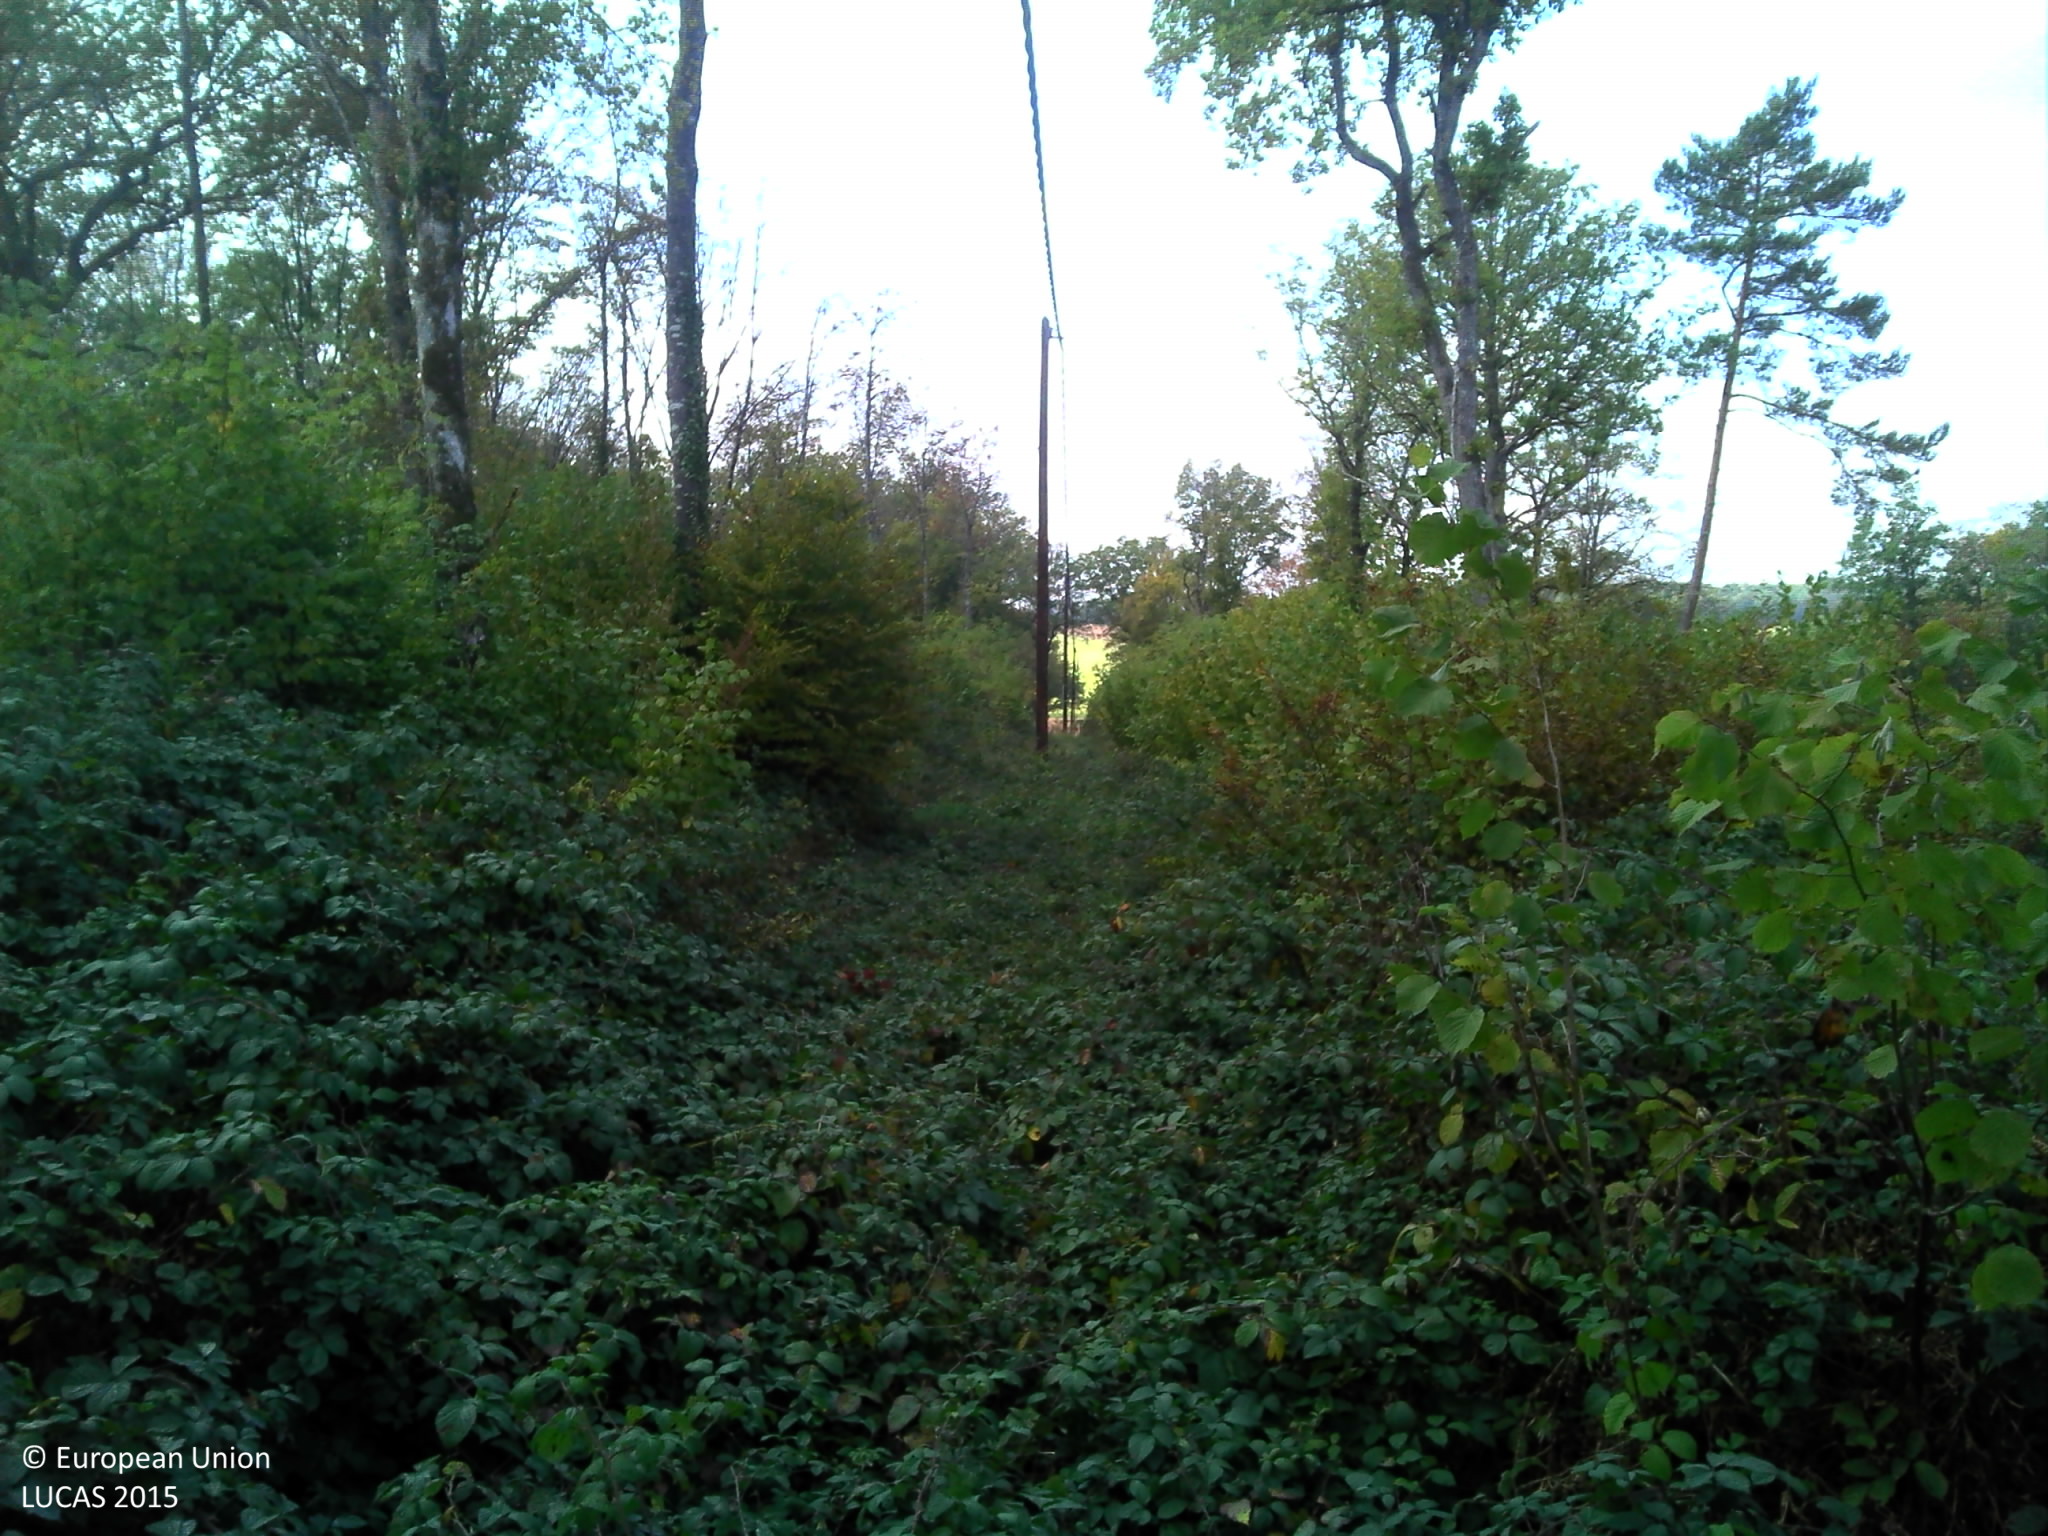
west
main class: Woodland
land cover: Broadleaved woodland
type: mesophytic deciduous forest
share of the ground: > 75 %
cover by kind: broadleaved forest trees 100 %
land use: Forestry
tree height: > 5 m
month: October
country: FR
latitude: 47.5626
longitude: 5.2555
